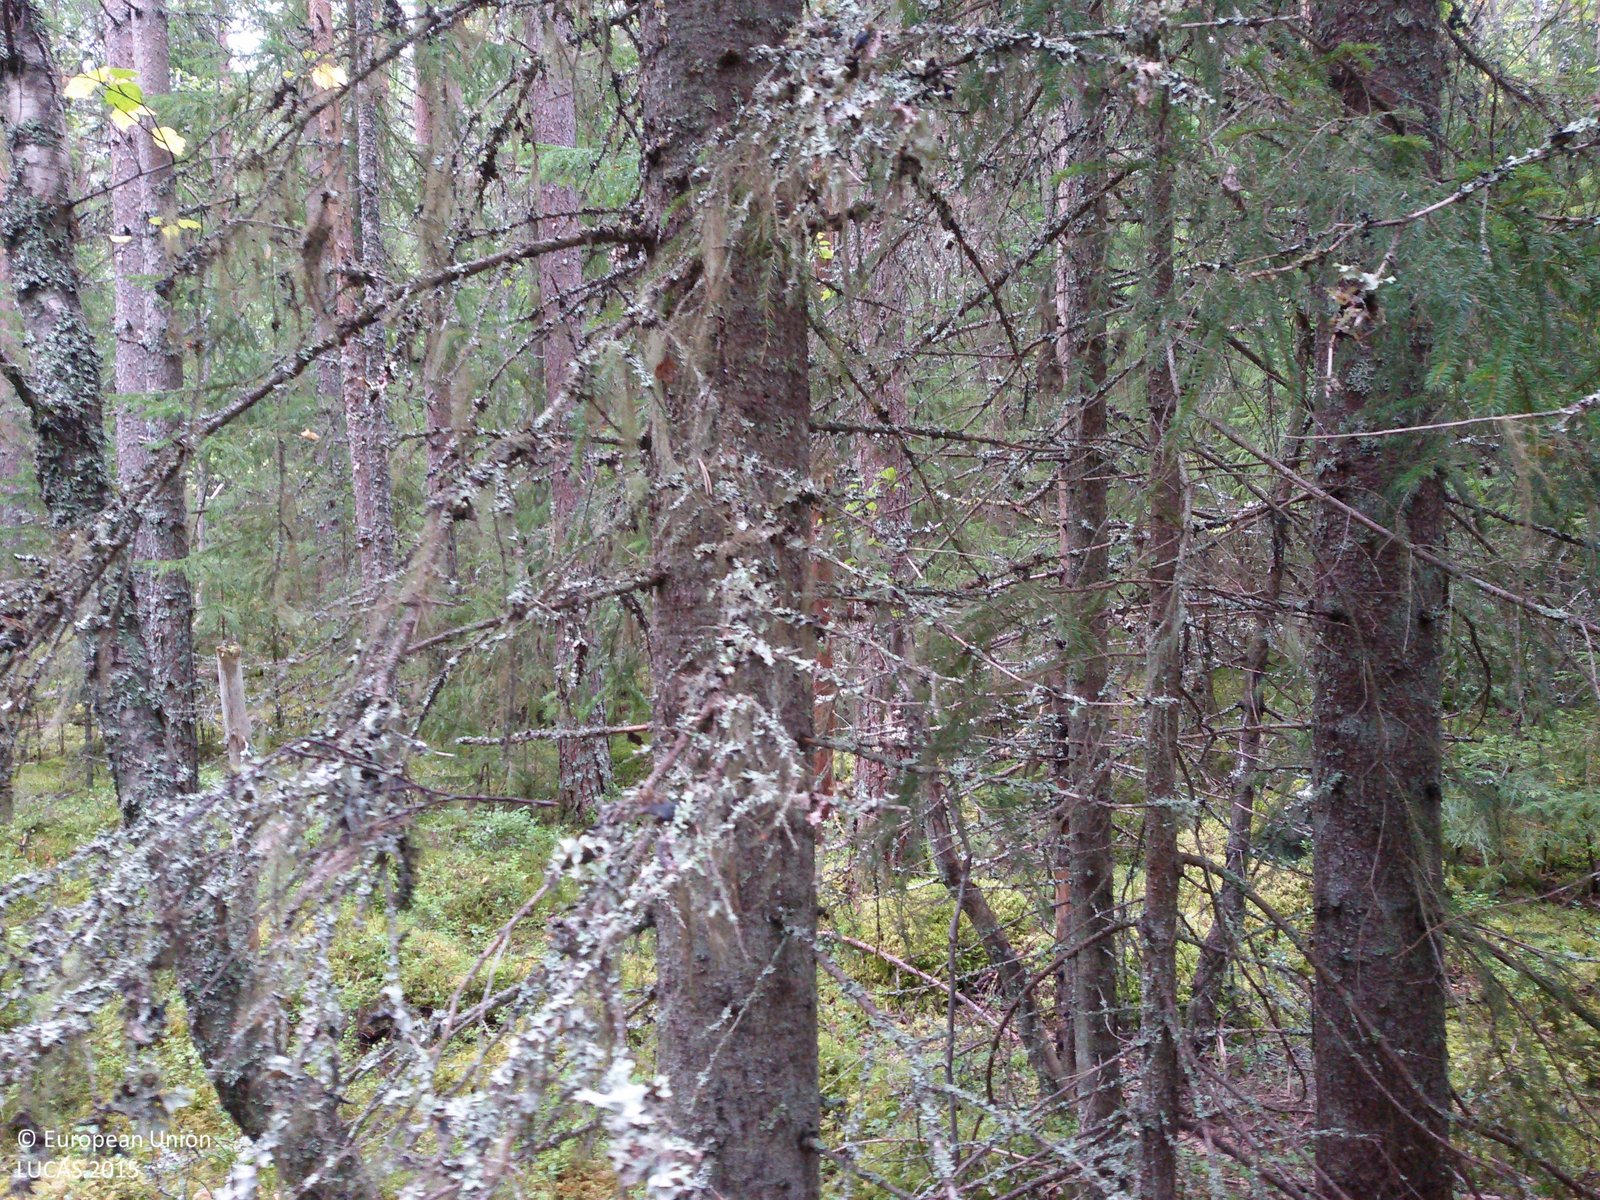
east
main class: Woodland
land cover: Spruce dominated coniferous woodland
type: boreal forest
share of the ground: > 75 %
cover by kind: coniferous forest trees 75 %, lichens and mosses 15 %, shrubs 10 %
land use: Forestry
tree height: > 5 m
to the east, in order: Spruce dominated coniferous woodland; Pine dominated coniferous woodland
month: September
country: SE
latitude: 60.7839
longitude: 15.3313
